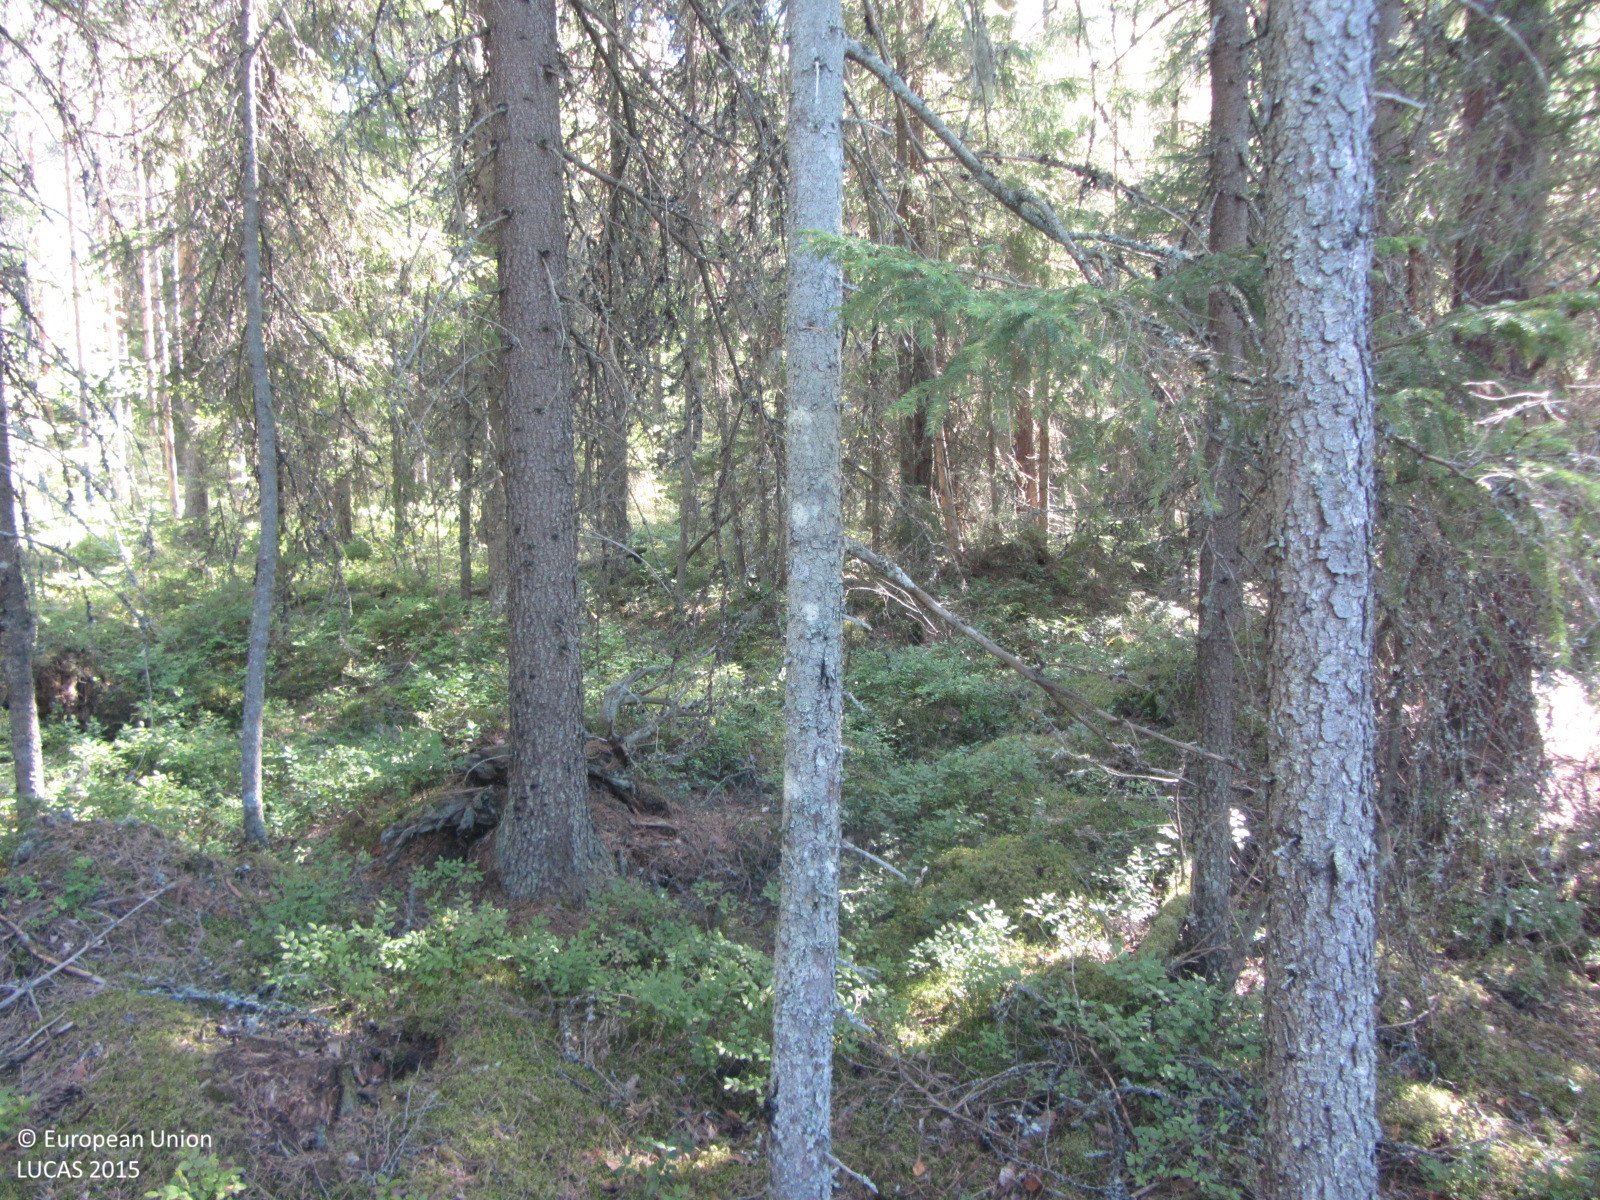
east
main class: Woodland
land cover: Other coniferous woodland
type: boreal forest
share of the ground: > 75 %
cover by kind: coniferous forest trees 80 %, shrubs 10 %, broadleaved forest trees 5 %, lichens and mosses 5 %
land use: Forestry
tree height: > 5 m
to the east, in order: Other coniferous woodland; Ditches and canals; Spruce dominated mixed woodland; Pine dominated mixed woodland; Ditches and canals; Spruce dominated mixed woodland; Paved roads, cycling and walking lanes; Pine dominated mixed woodland; Pine dominated coniferous woodland
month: August
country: FI
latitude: 61.3445
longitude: 25.1245
